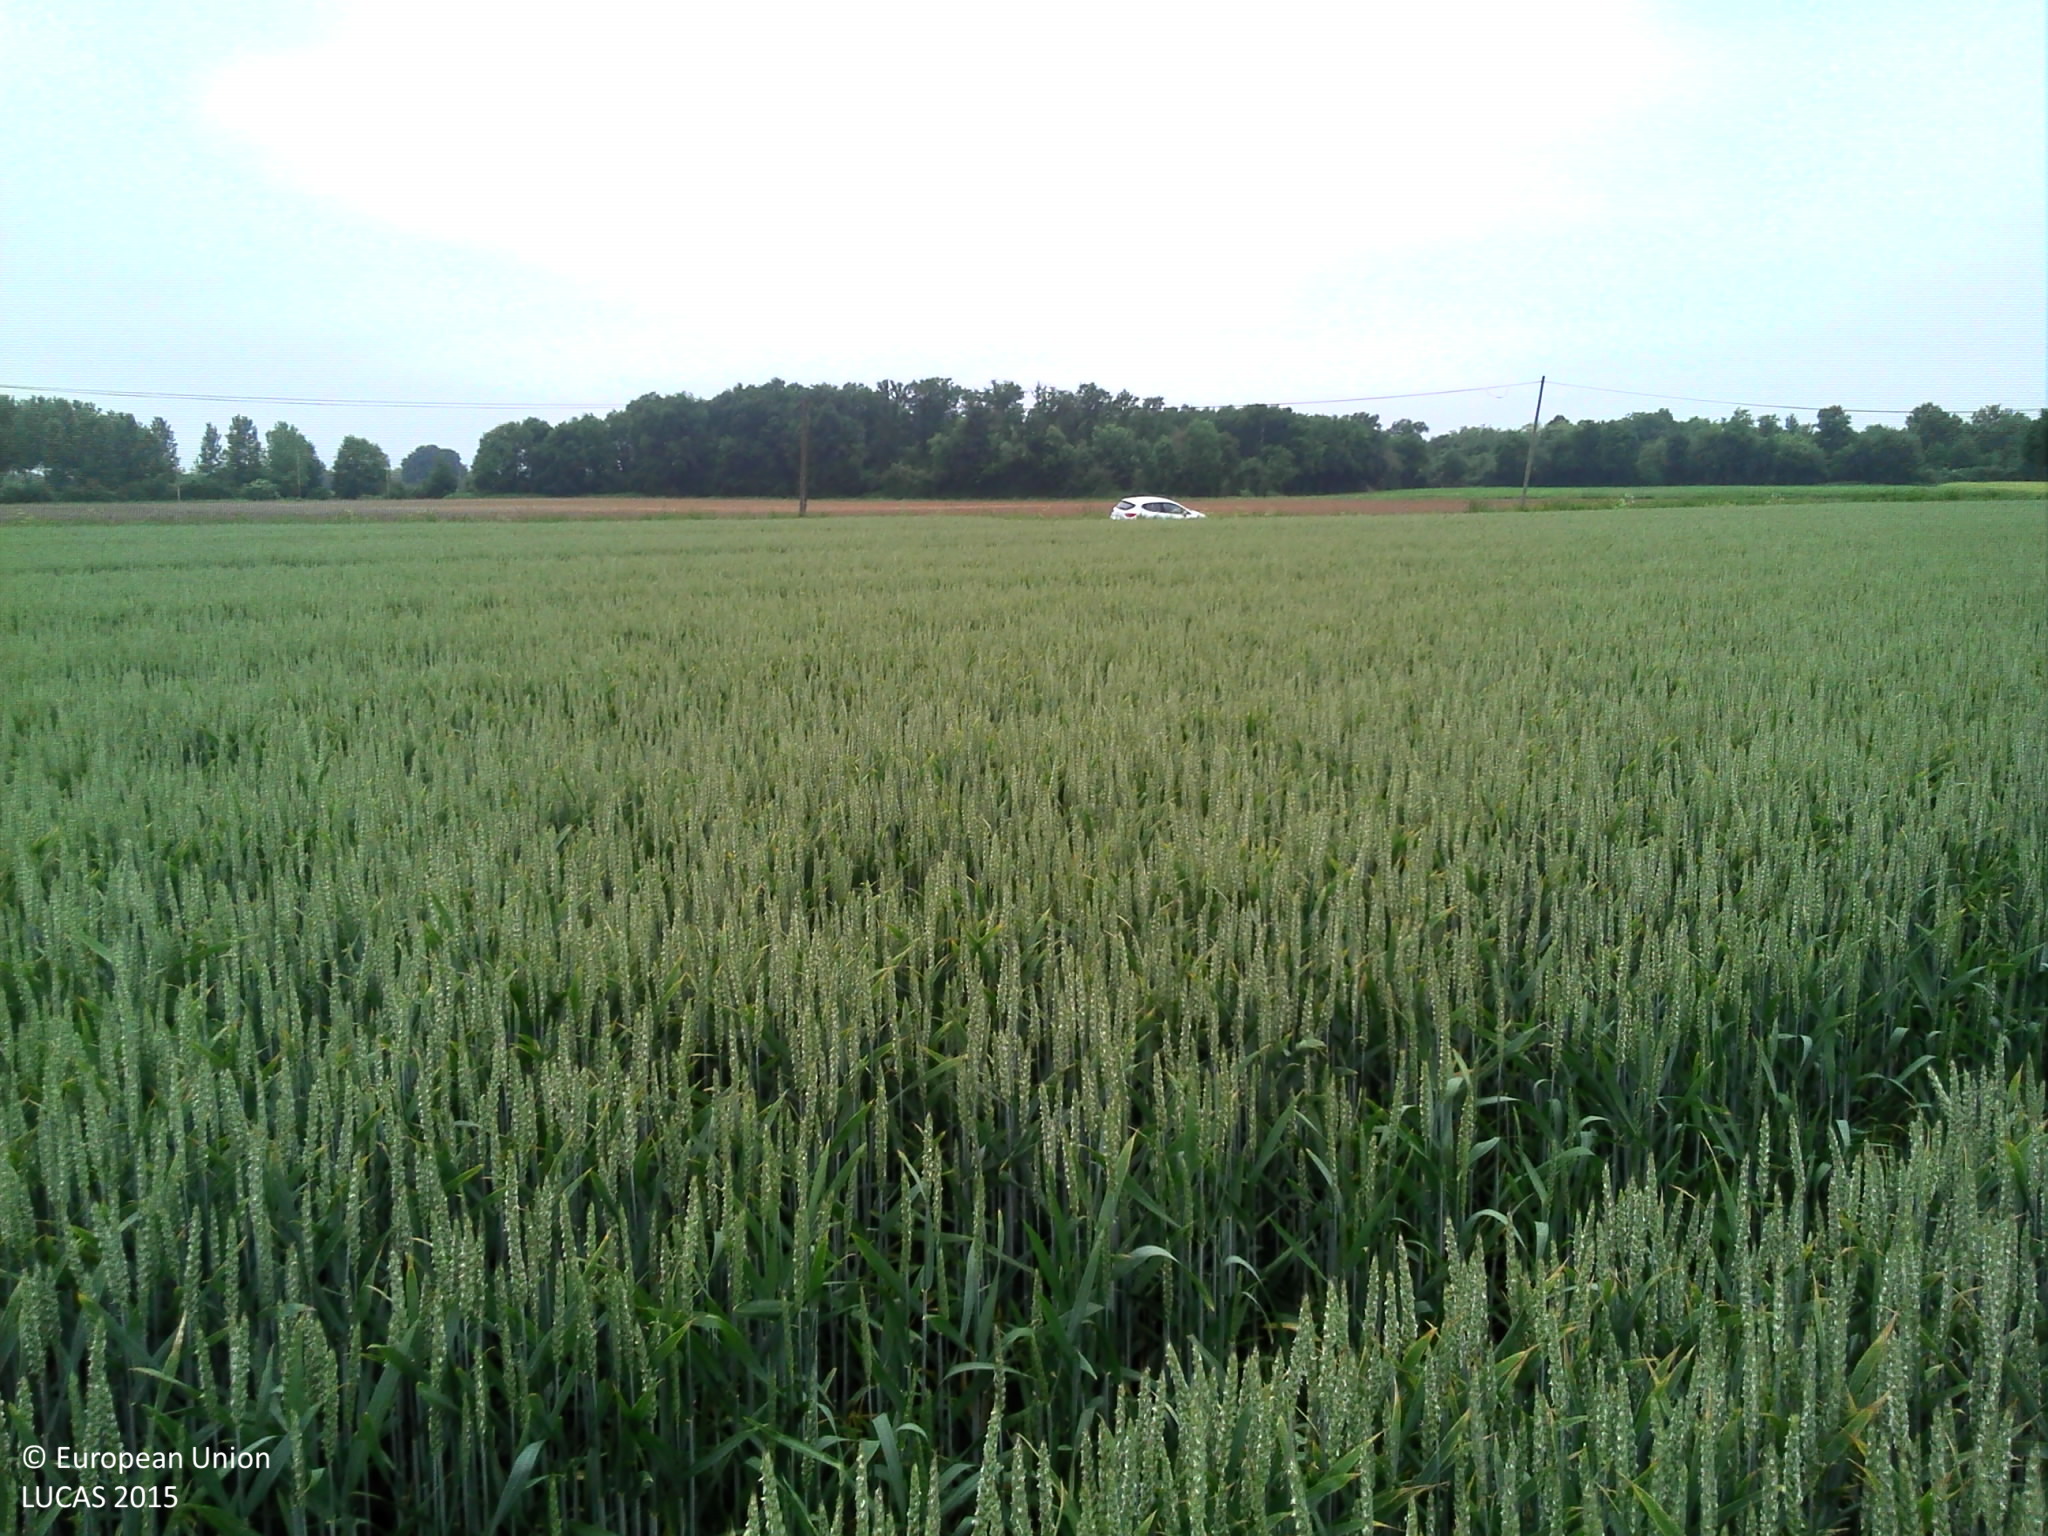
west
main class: Cropland
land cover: Common wheat
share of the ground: > 75 %
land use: Agriculture (excluding fallow land and kitchen gardens)
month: May
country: FR
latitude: 47.0686
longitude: 0.0875
